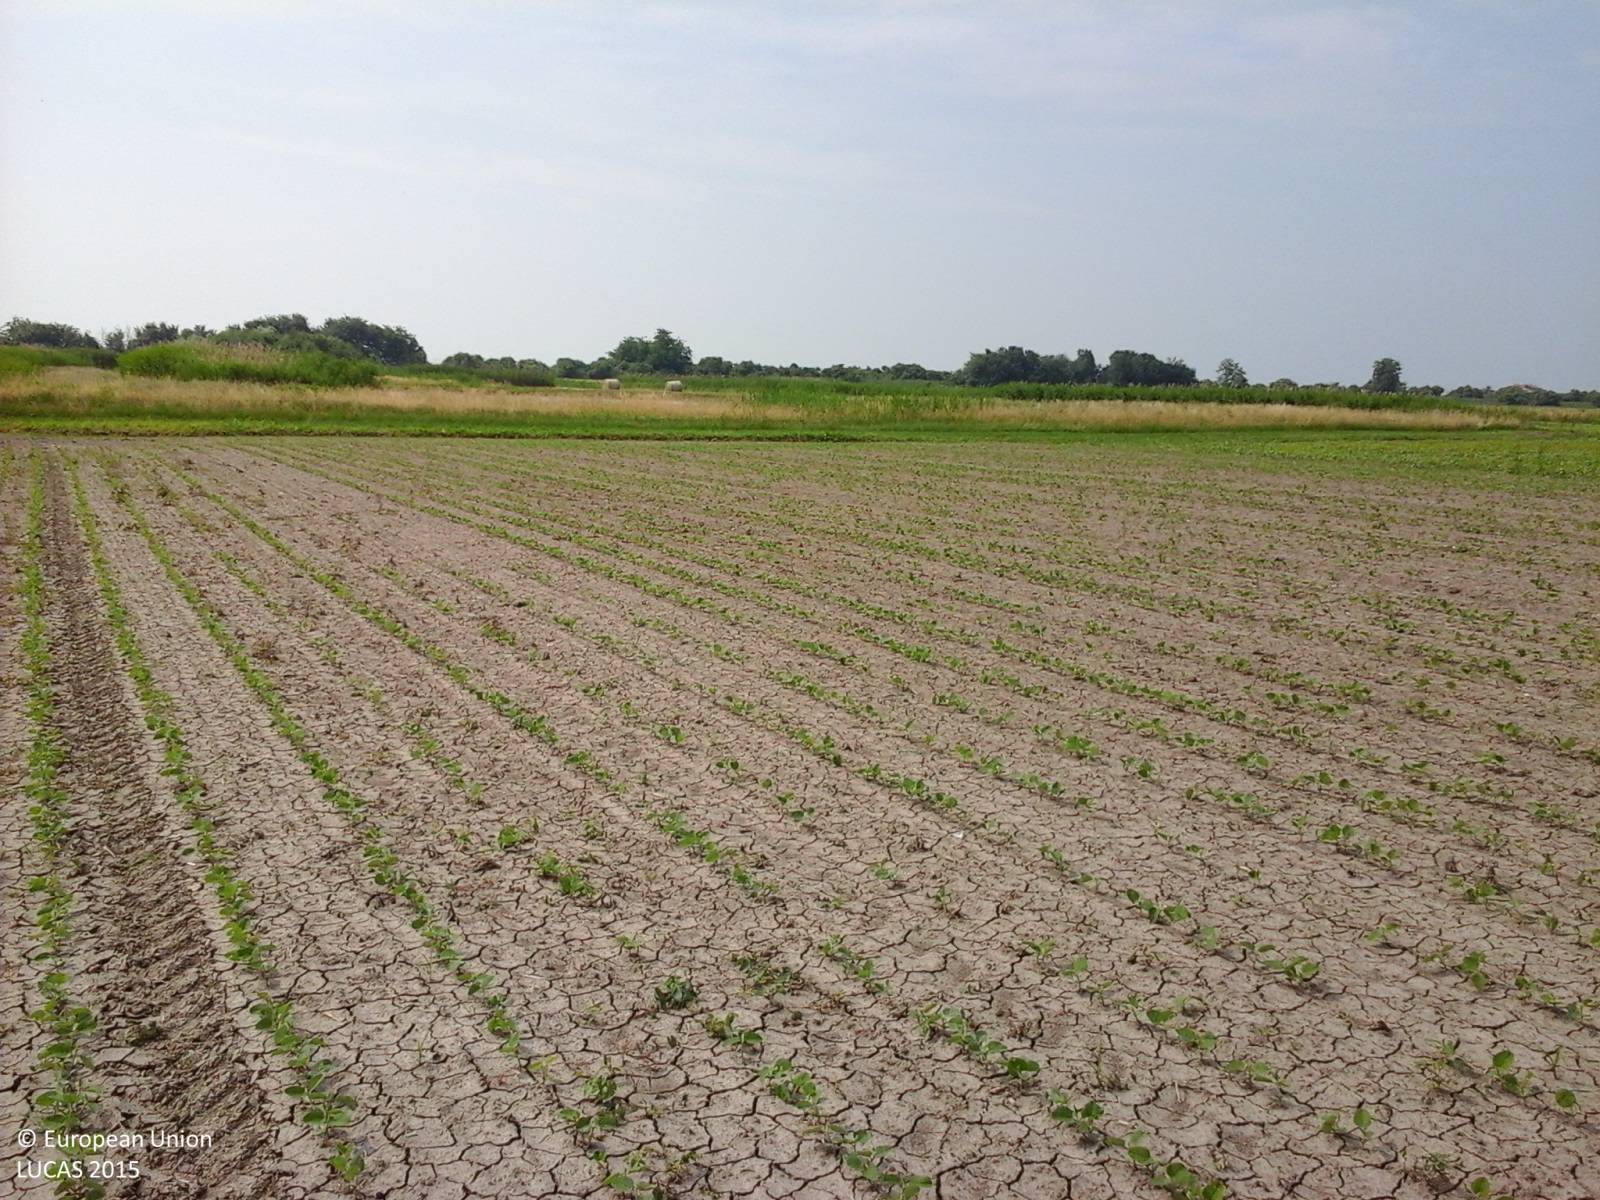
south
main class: Cropland
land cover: Soya
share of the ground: < 10 %
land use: Agriculture (excluding fallow land and kitchen gardens)
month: May
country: IT
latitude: 45.7594
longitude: 13.3001
